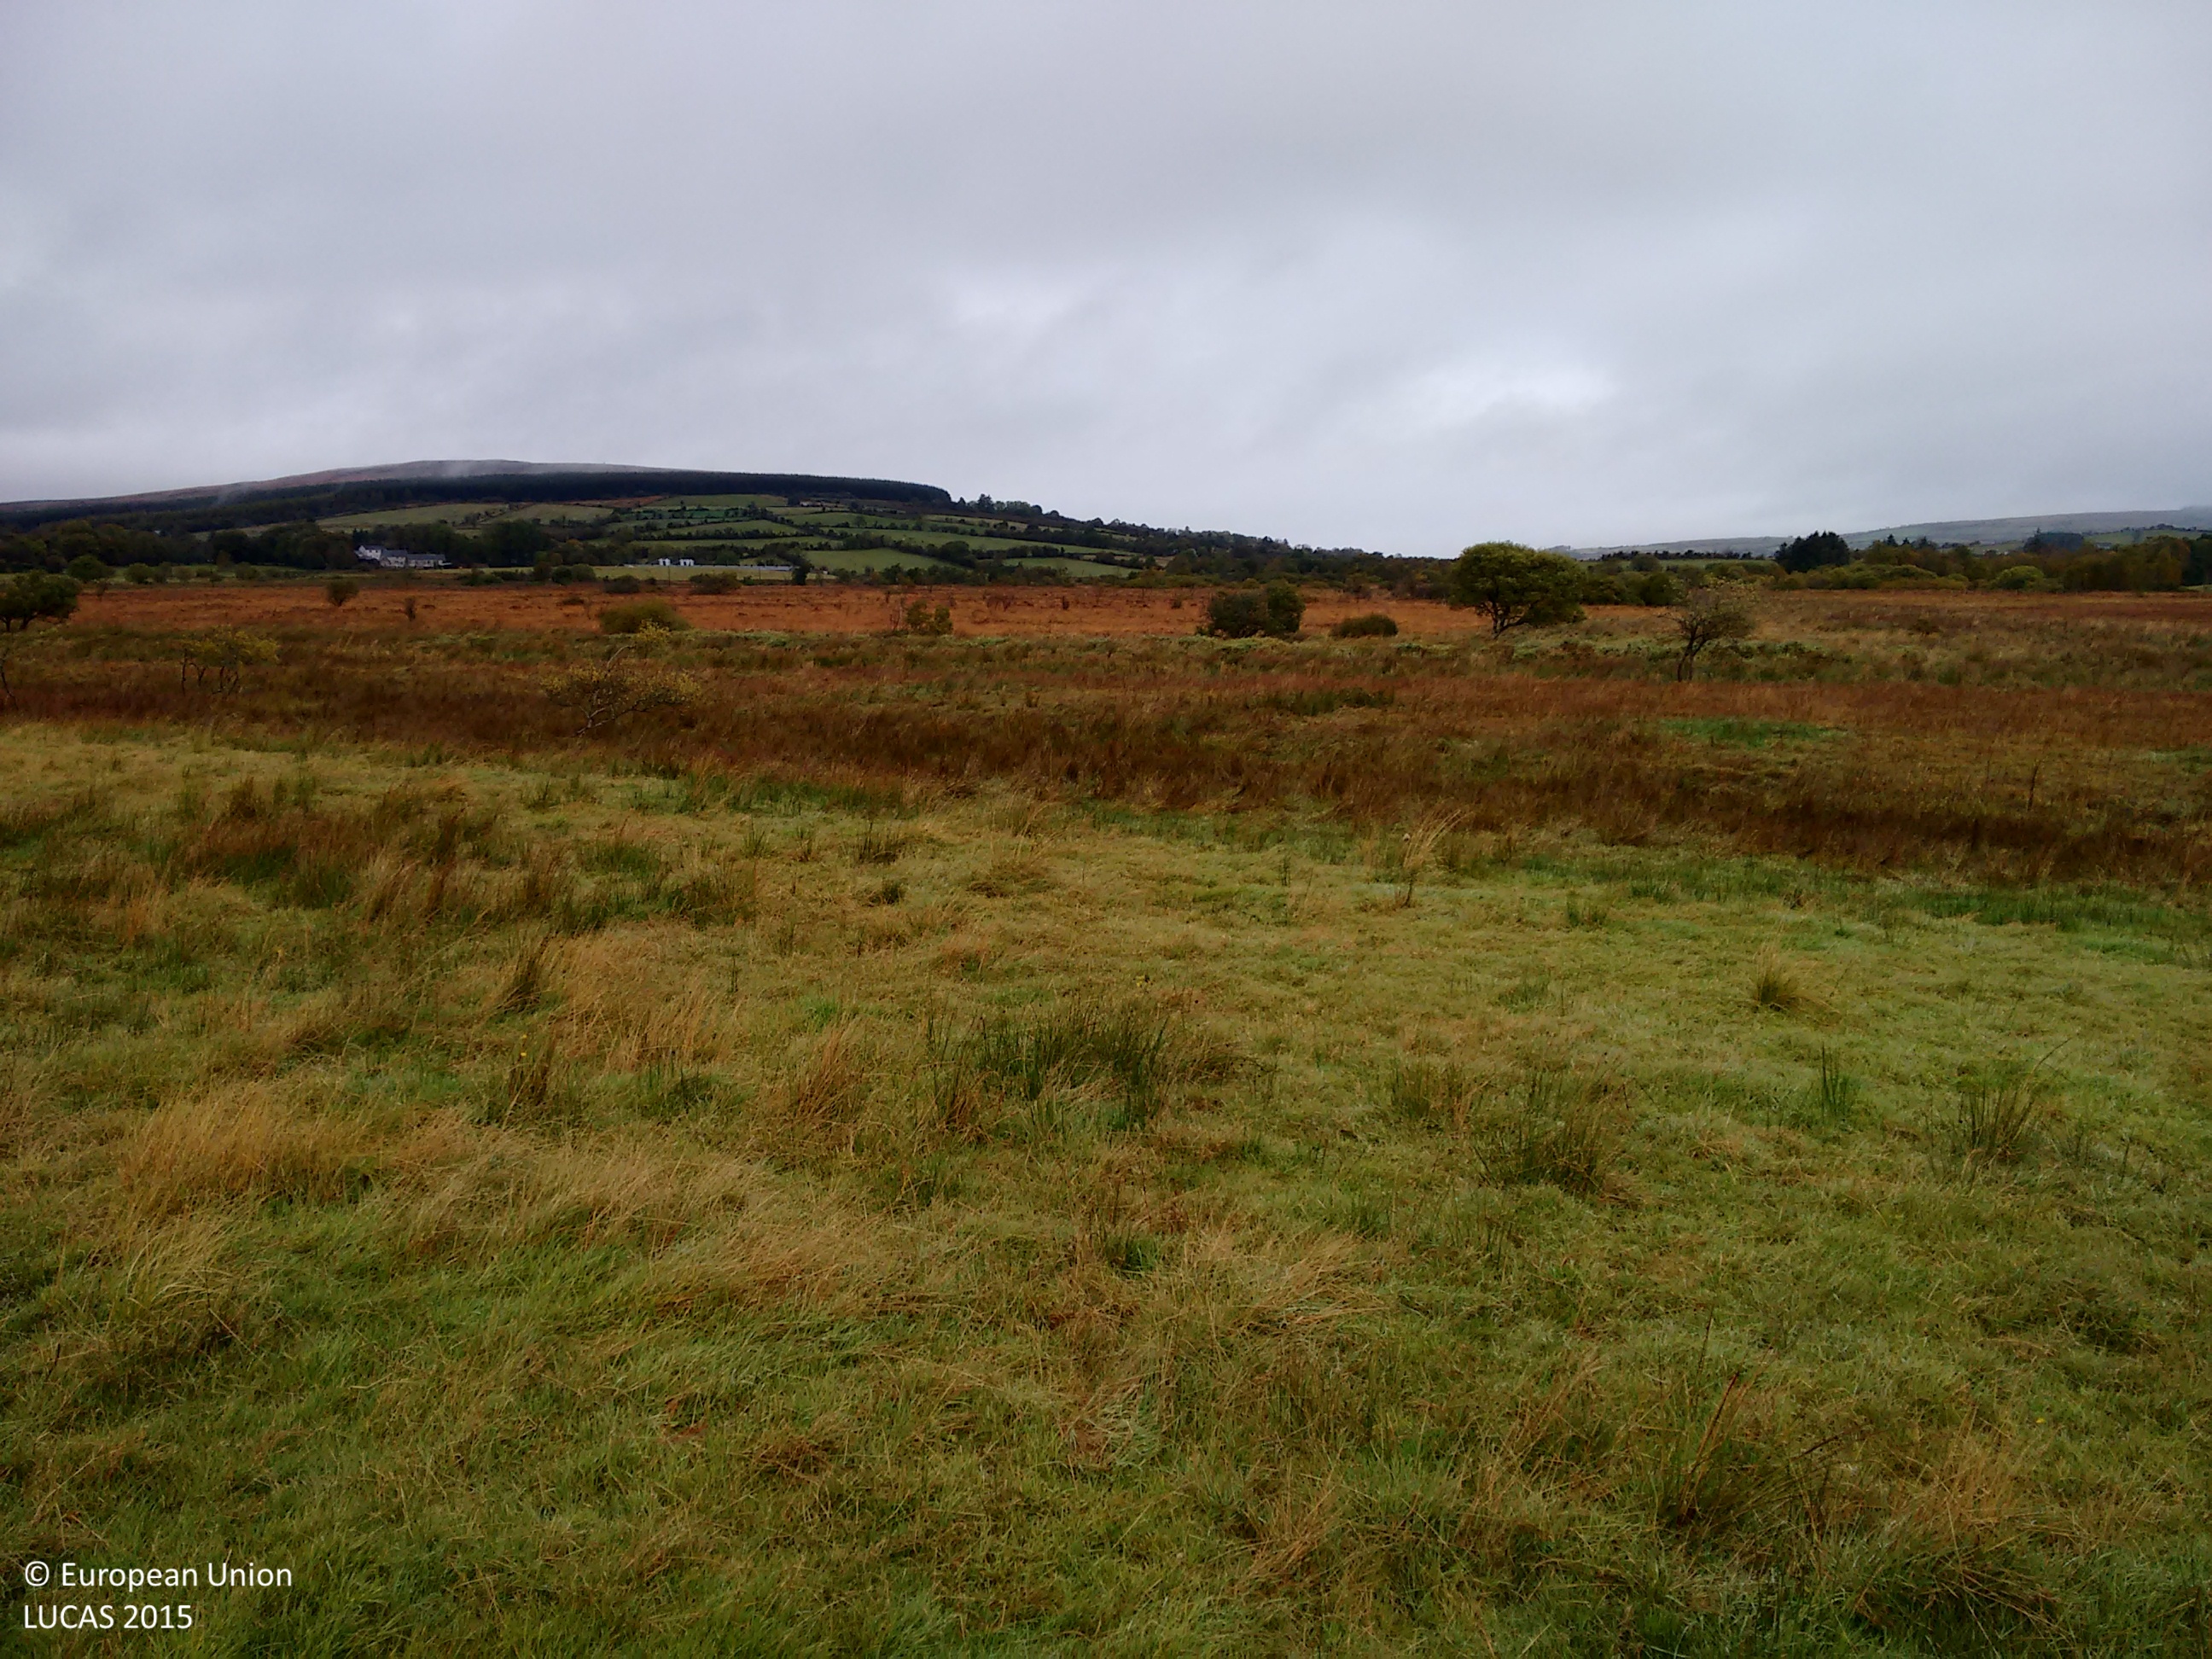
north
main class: Grassland
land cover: Grassland without tree/shrub cover
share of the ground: > 75 %
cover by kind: herbaceous plants 100 %
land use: Agriculture (excluding fallow land and kitchen gardens)
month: October
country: GB
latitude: 54.5481
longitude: -7.4853
